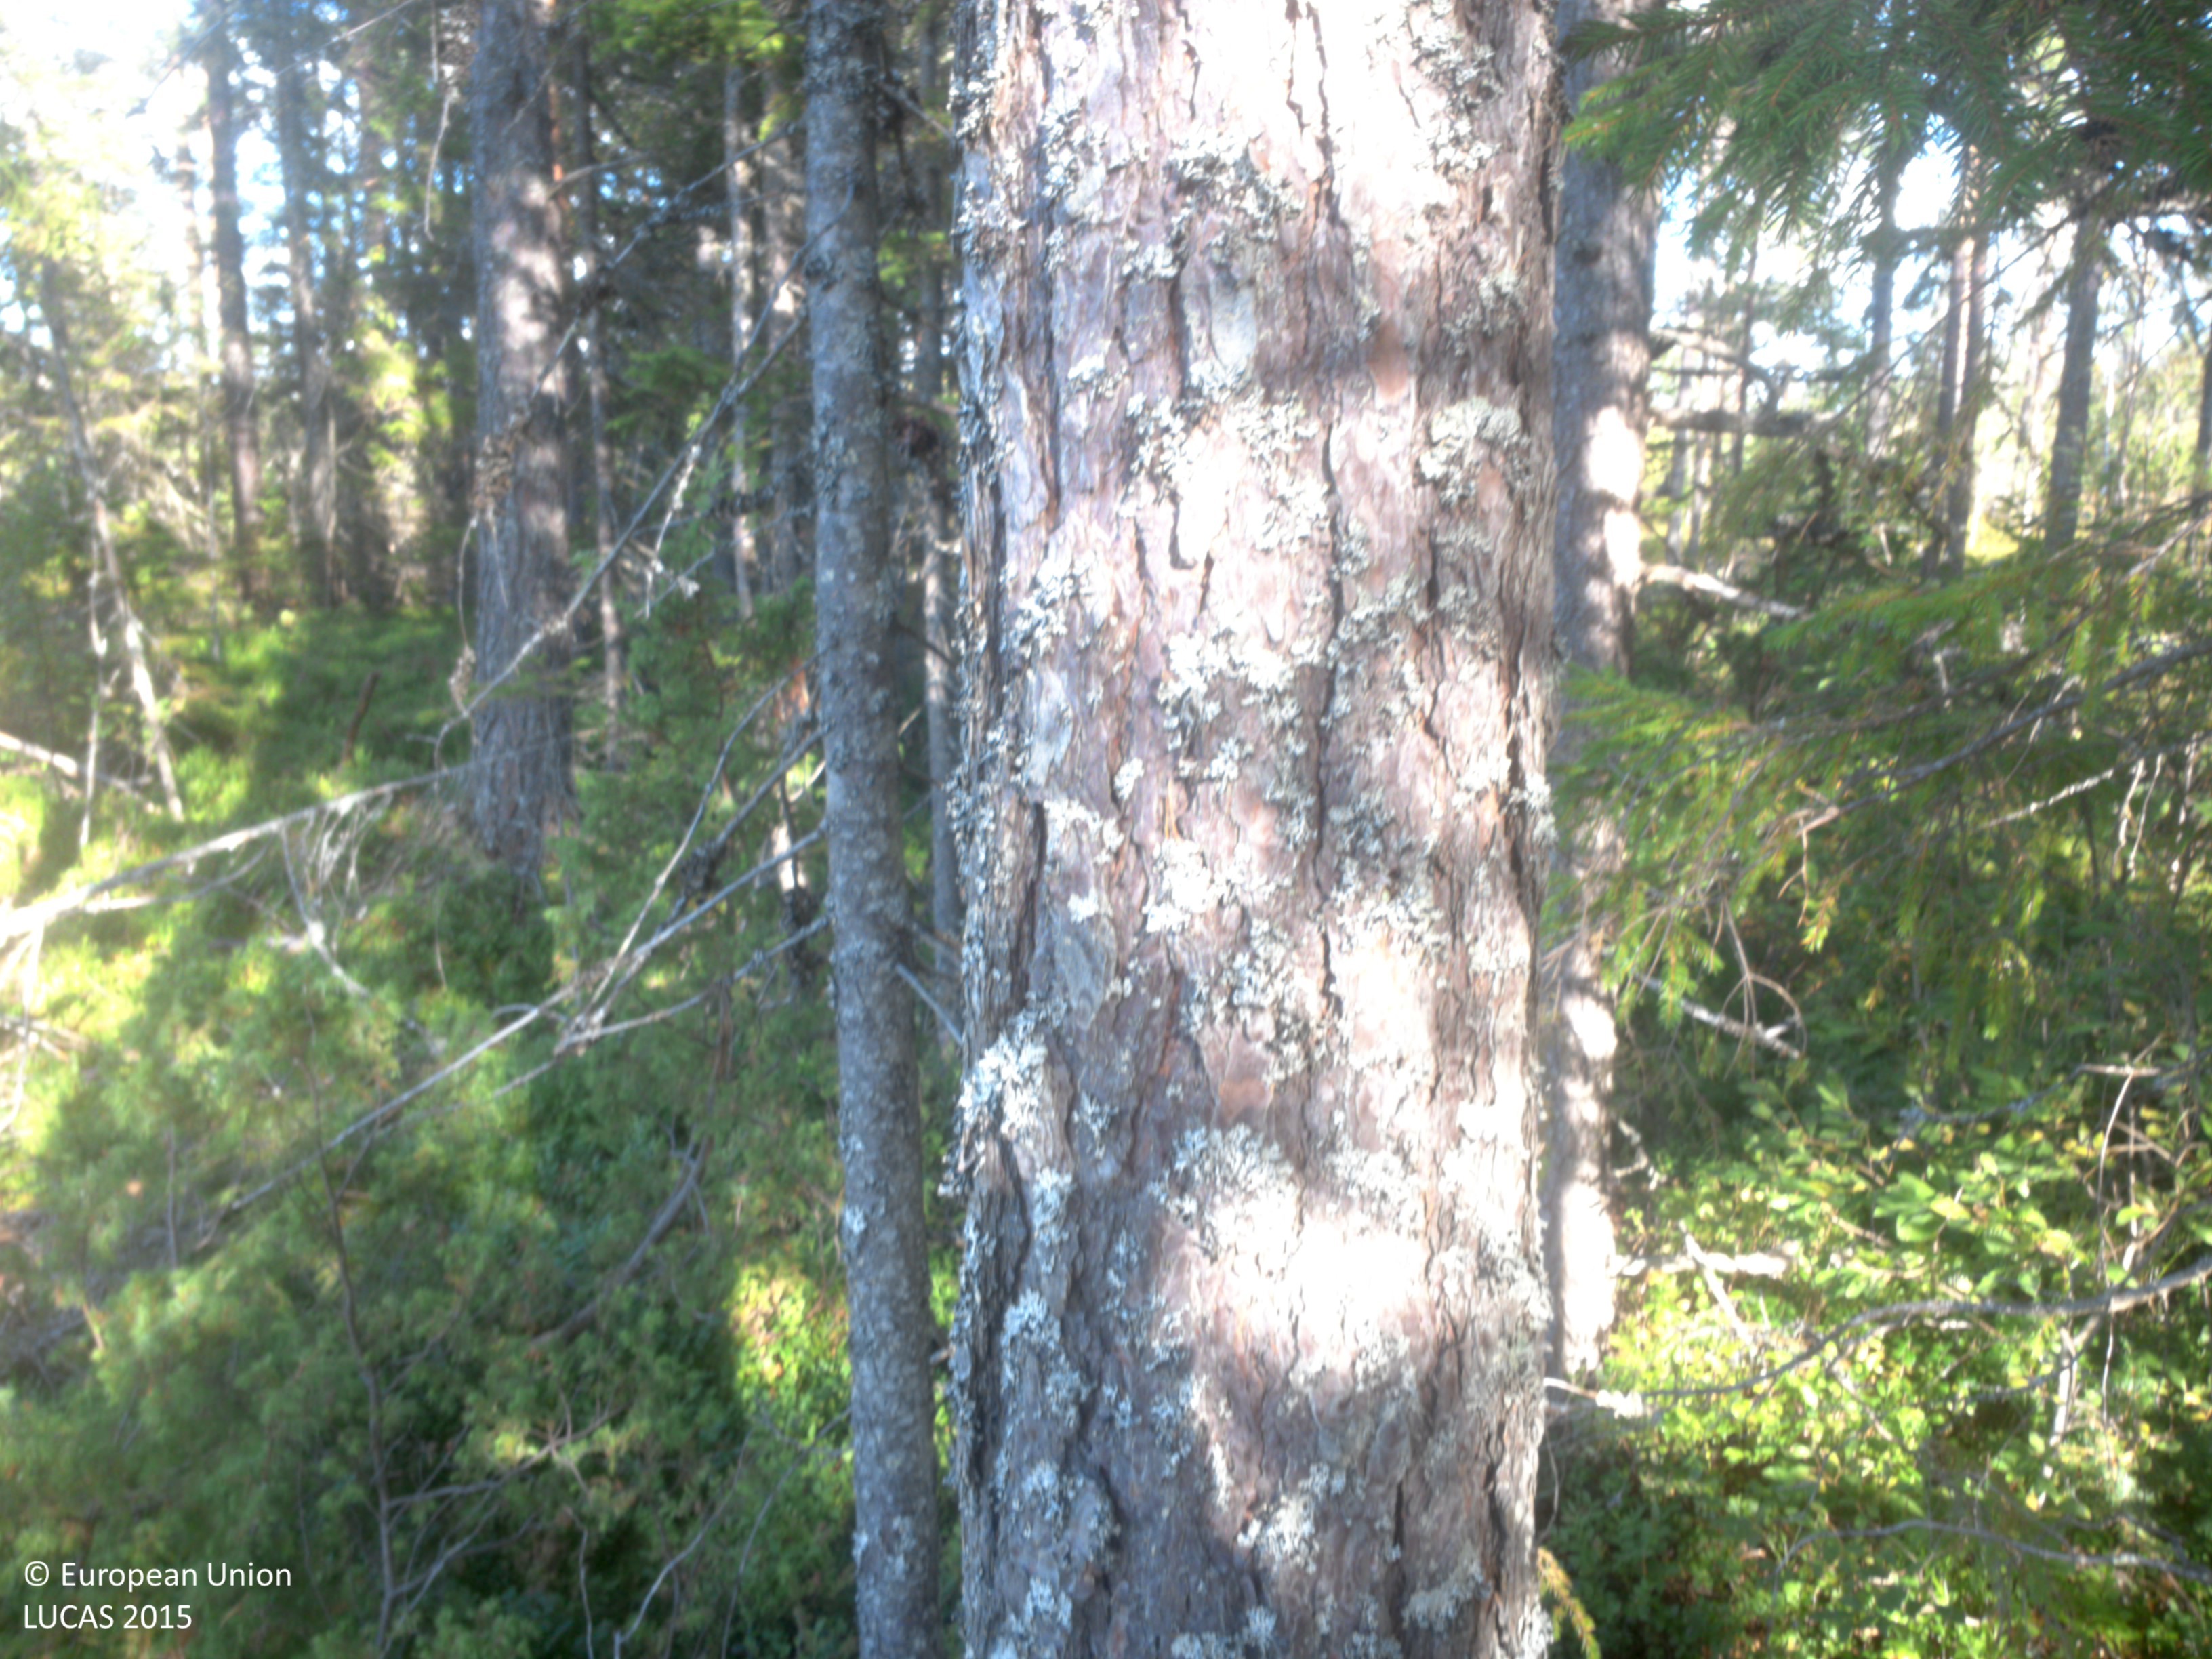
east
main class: Woodland
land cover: Other coniferous woodland
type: boreal forest
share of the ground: 50 - 75 %
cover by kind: coniferous forest trees 50 %, shrubs 50 %
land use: Forestry
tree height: > 5 m
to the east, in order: Other coniferous woodland; Pine dominated coniferous woodland; Broadleaved woodland; Pine dominated mixed woodland
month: August
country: SE
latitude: 63.7886
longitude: 20.0255
